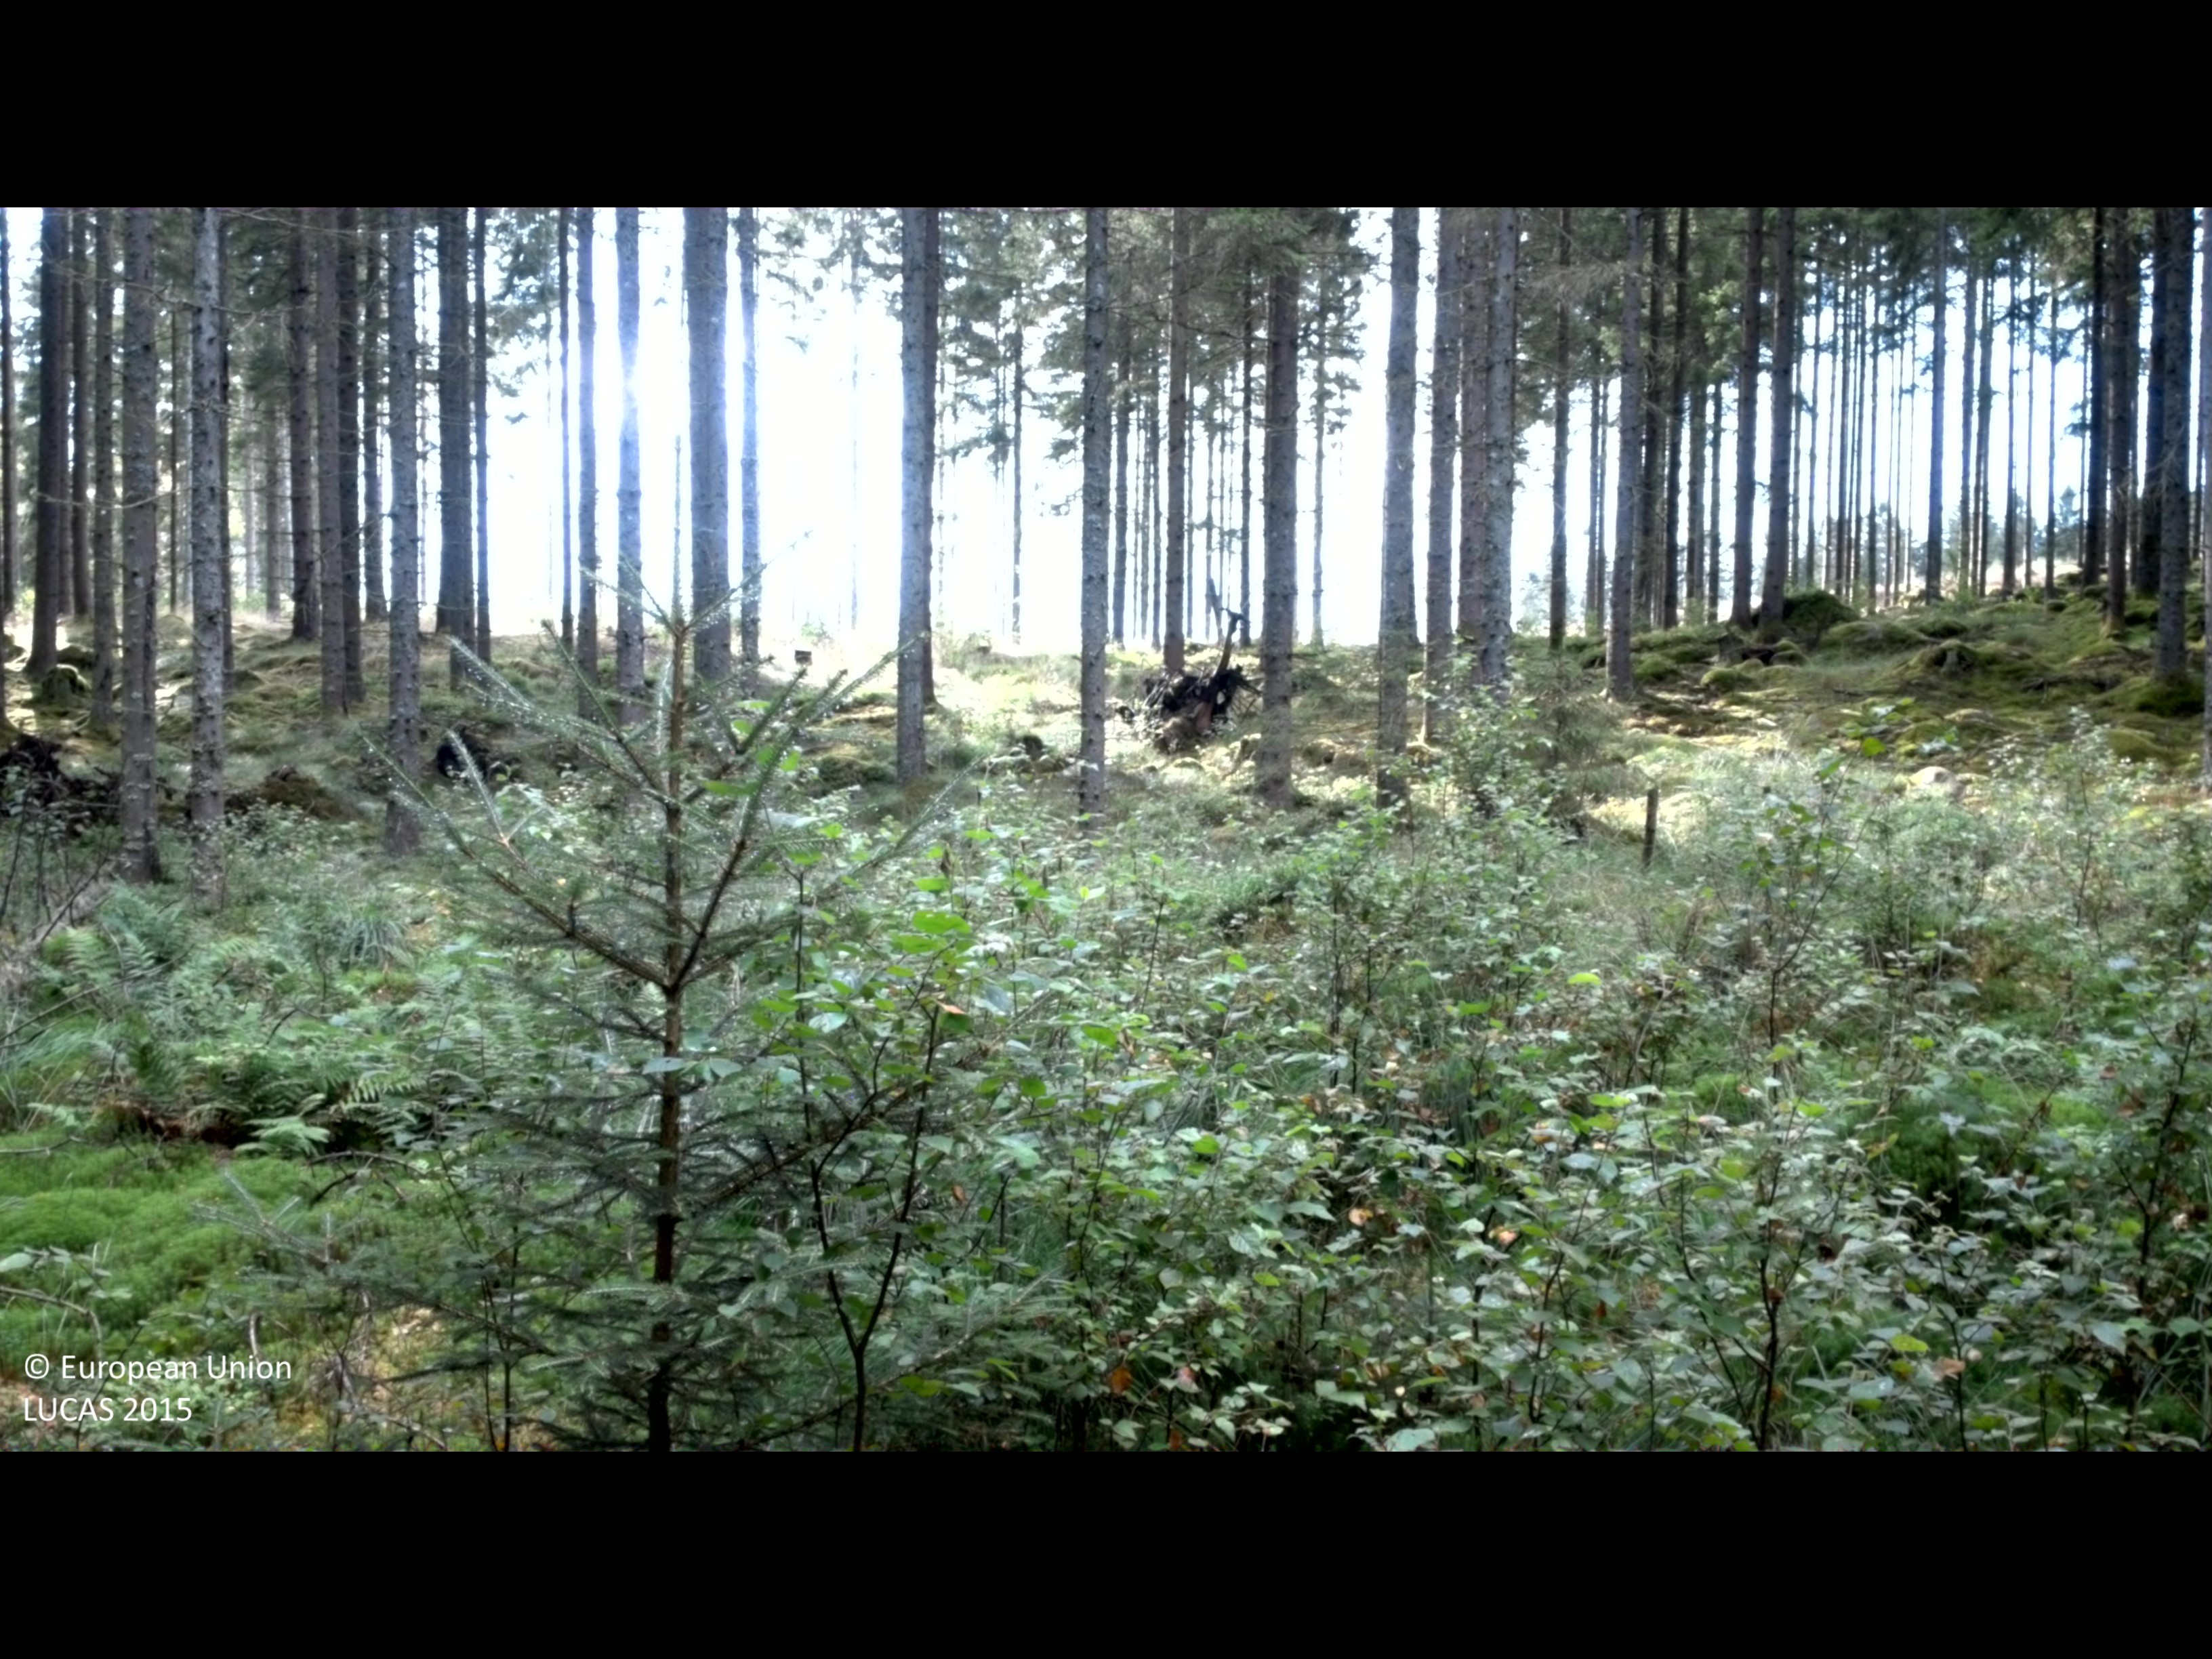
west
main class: Woodland
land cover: Spruce dominated coniferous woodland
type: boreal forest
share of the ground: 50 - 75 %
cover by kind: coniferous forest trees 60 %, shrubs 30 %, broadleaved forest trees 5 %, lichens and mosses 5 %
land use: Forestry
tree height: > 5 m
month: August
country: SE
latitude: 57.0465
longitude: 13.2435
